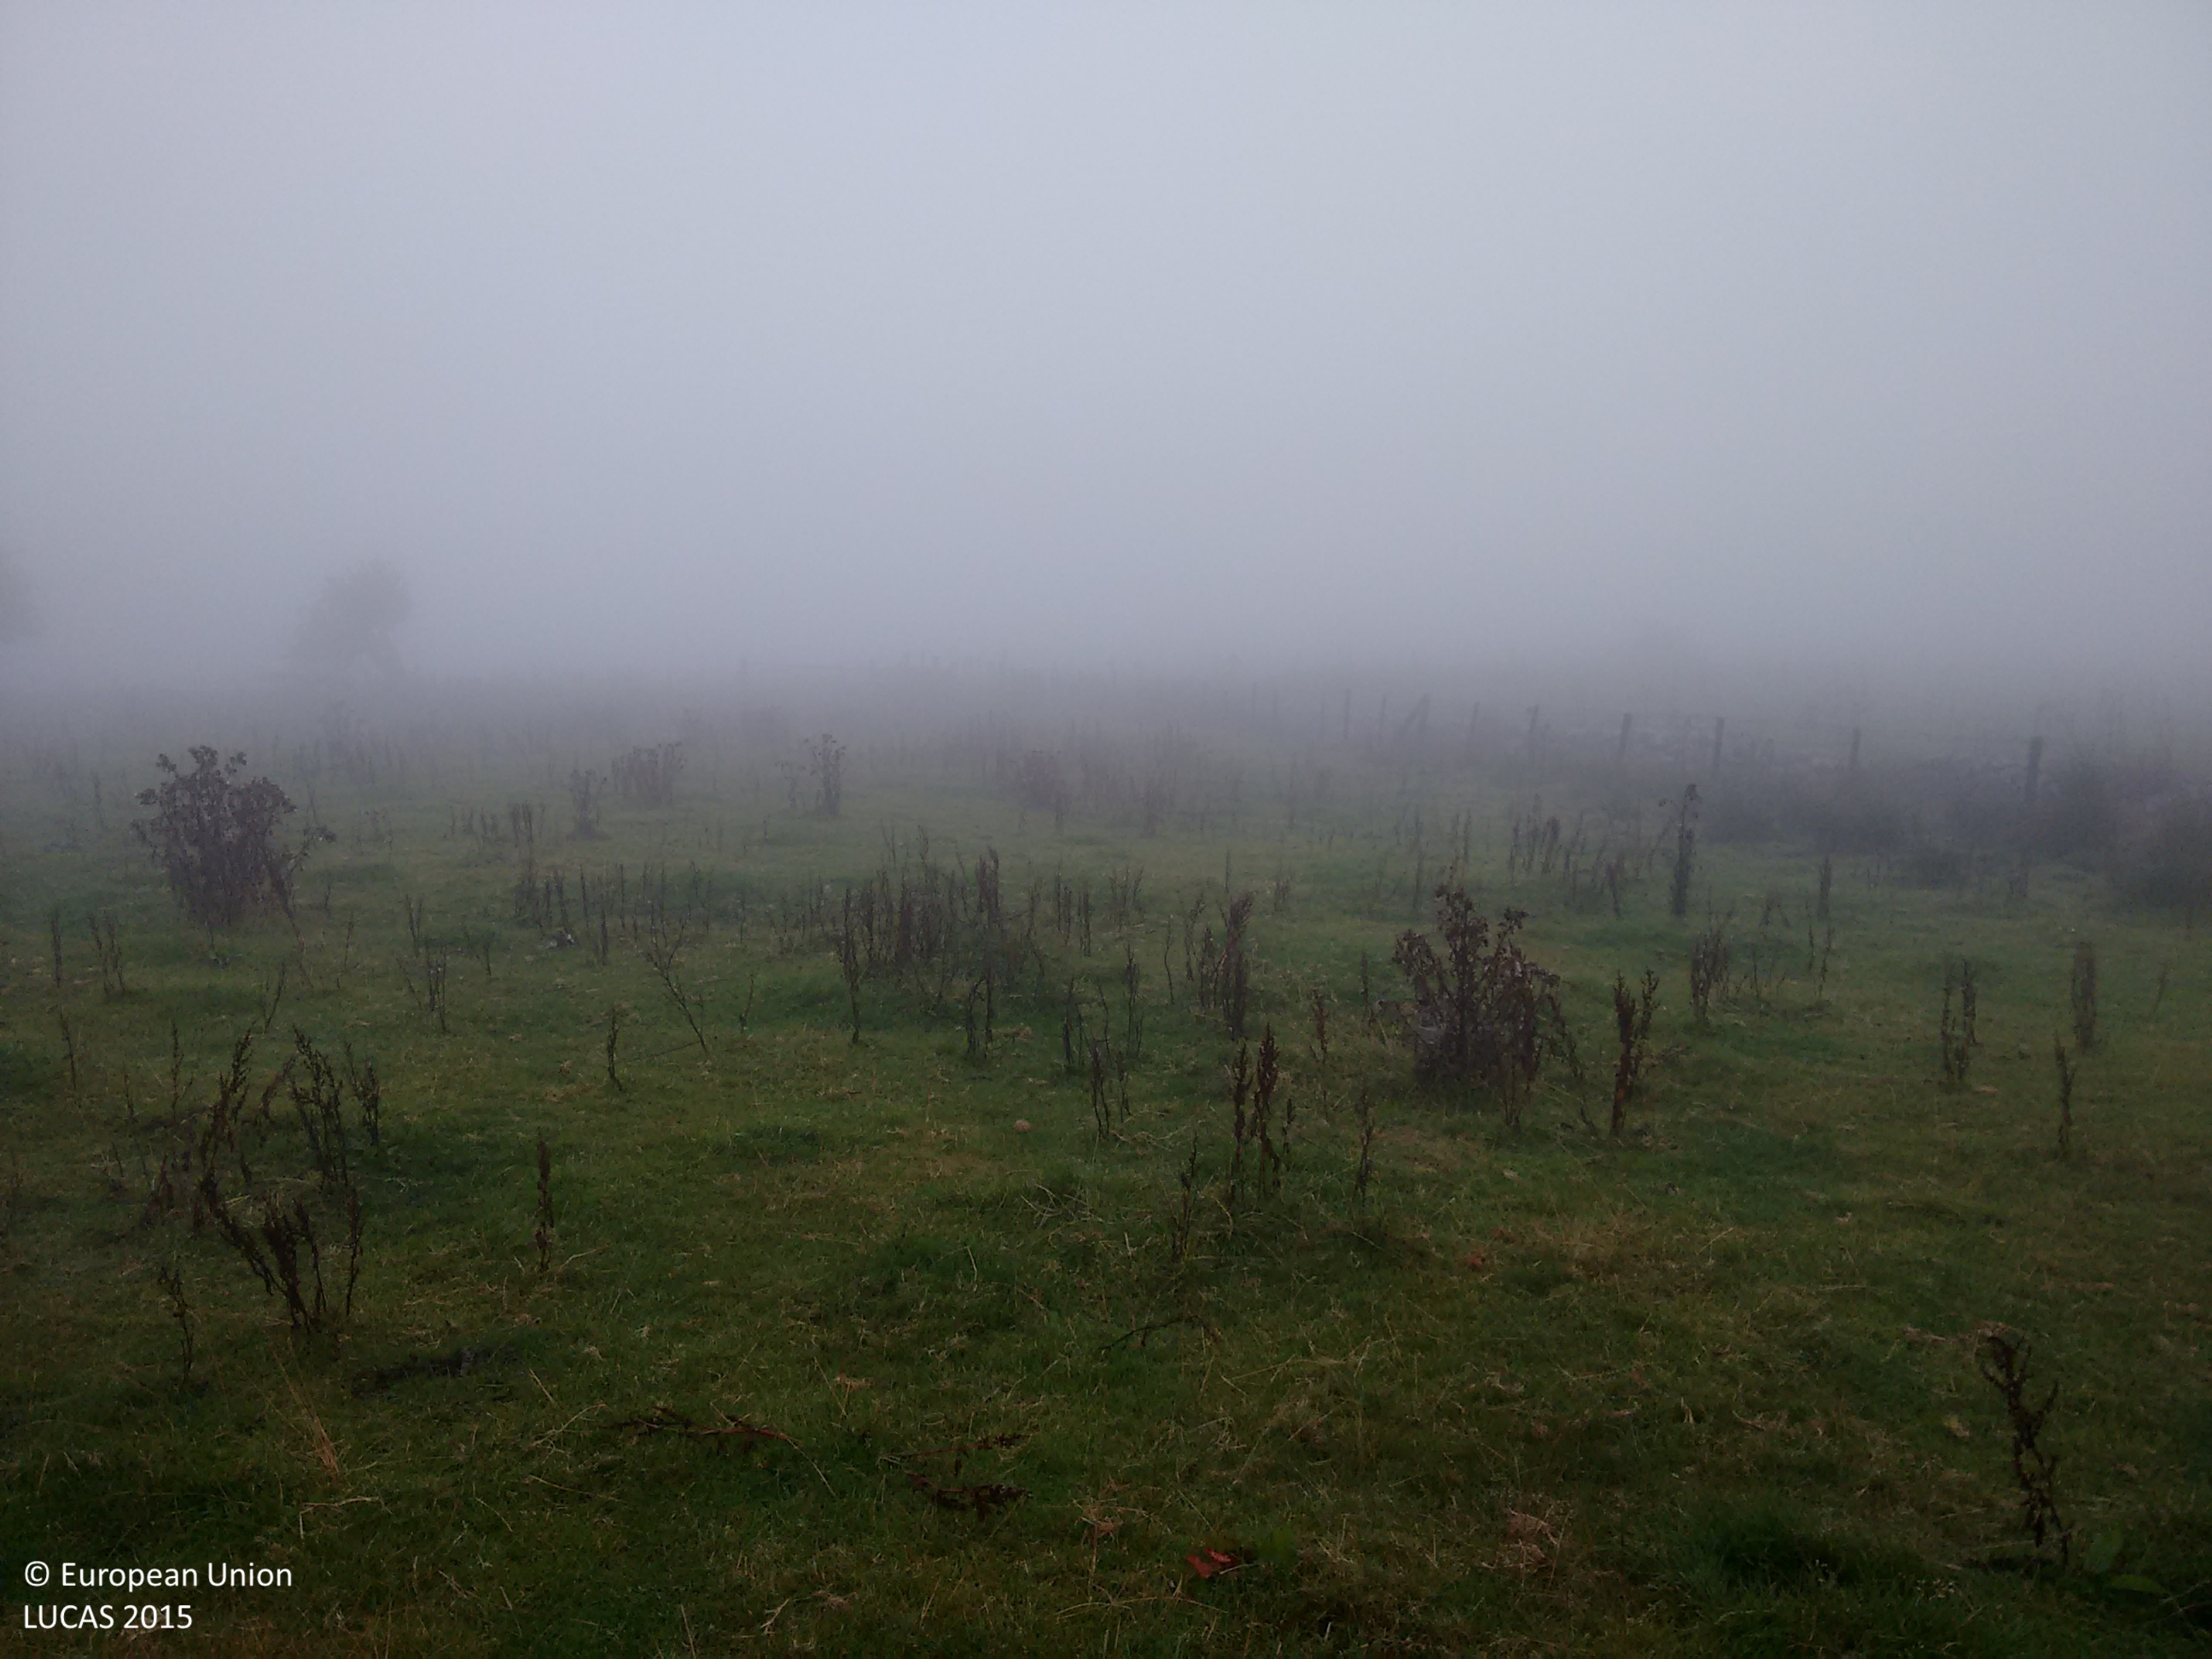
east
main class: Grassland
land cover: Grassland without tree/shrub cover
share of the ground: > 75 %
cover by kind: herbaceous plants 100 %
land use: Agriculture (excluding fallow land and kitchen gardens)
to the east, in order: Grassland without tree/shrub cover; Fences; Grassland without tree/shrub cover
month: September
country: GB
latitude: 52.5778
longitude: -2.9269
